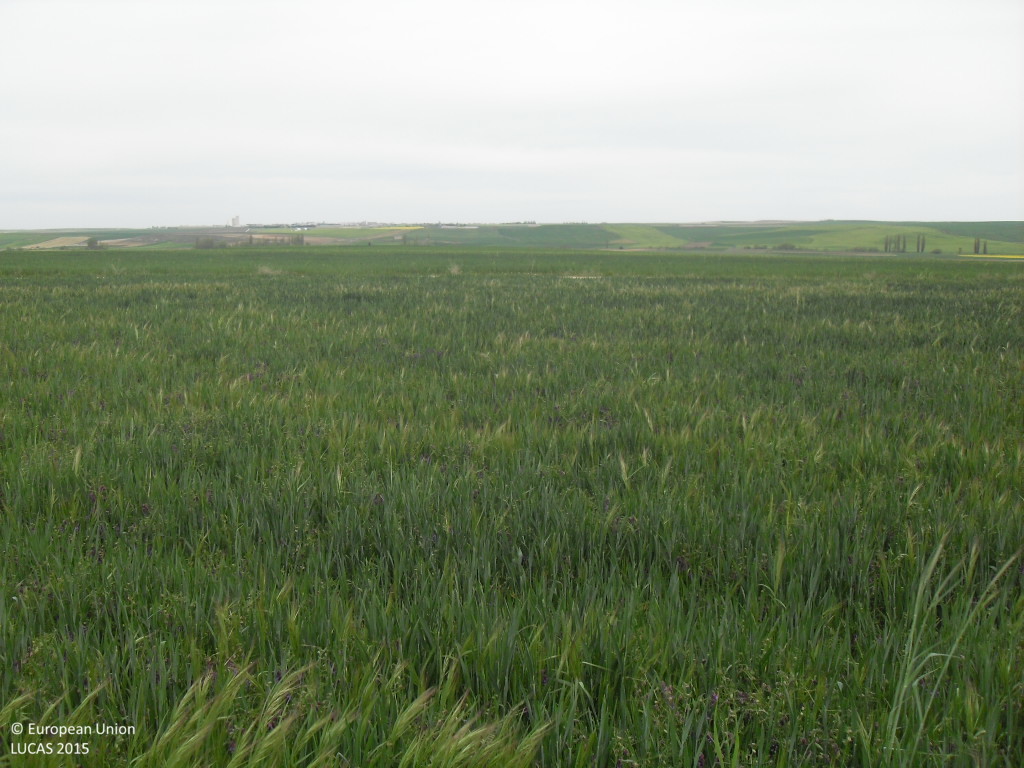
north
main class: Cropland
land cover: Mixed cereals for fodder
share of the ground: > 75 %
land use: Agriculture (excluding fallow land and kitchen gardens)
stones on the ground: 10 - 25 %
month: April
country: ES
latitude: 40.8403
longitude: -5.1879
